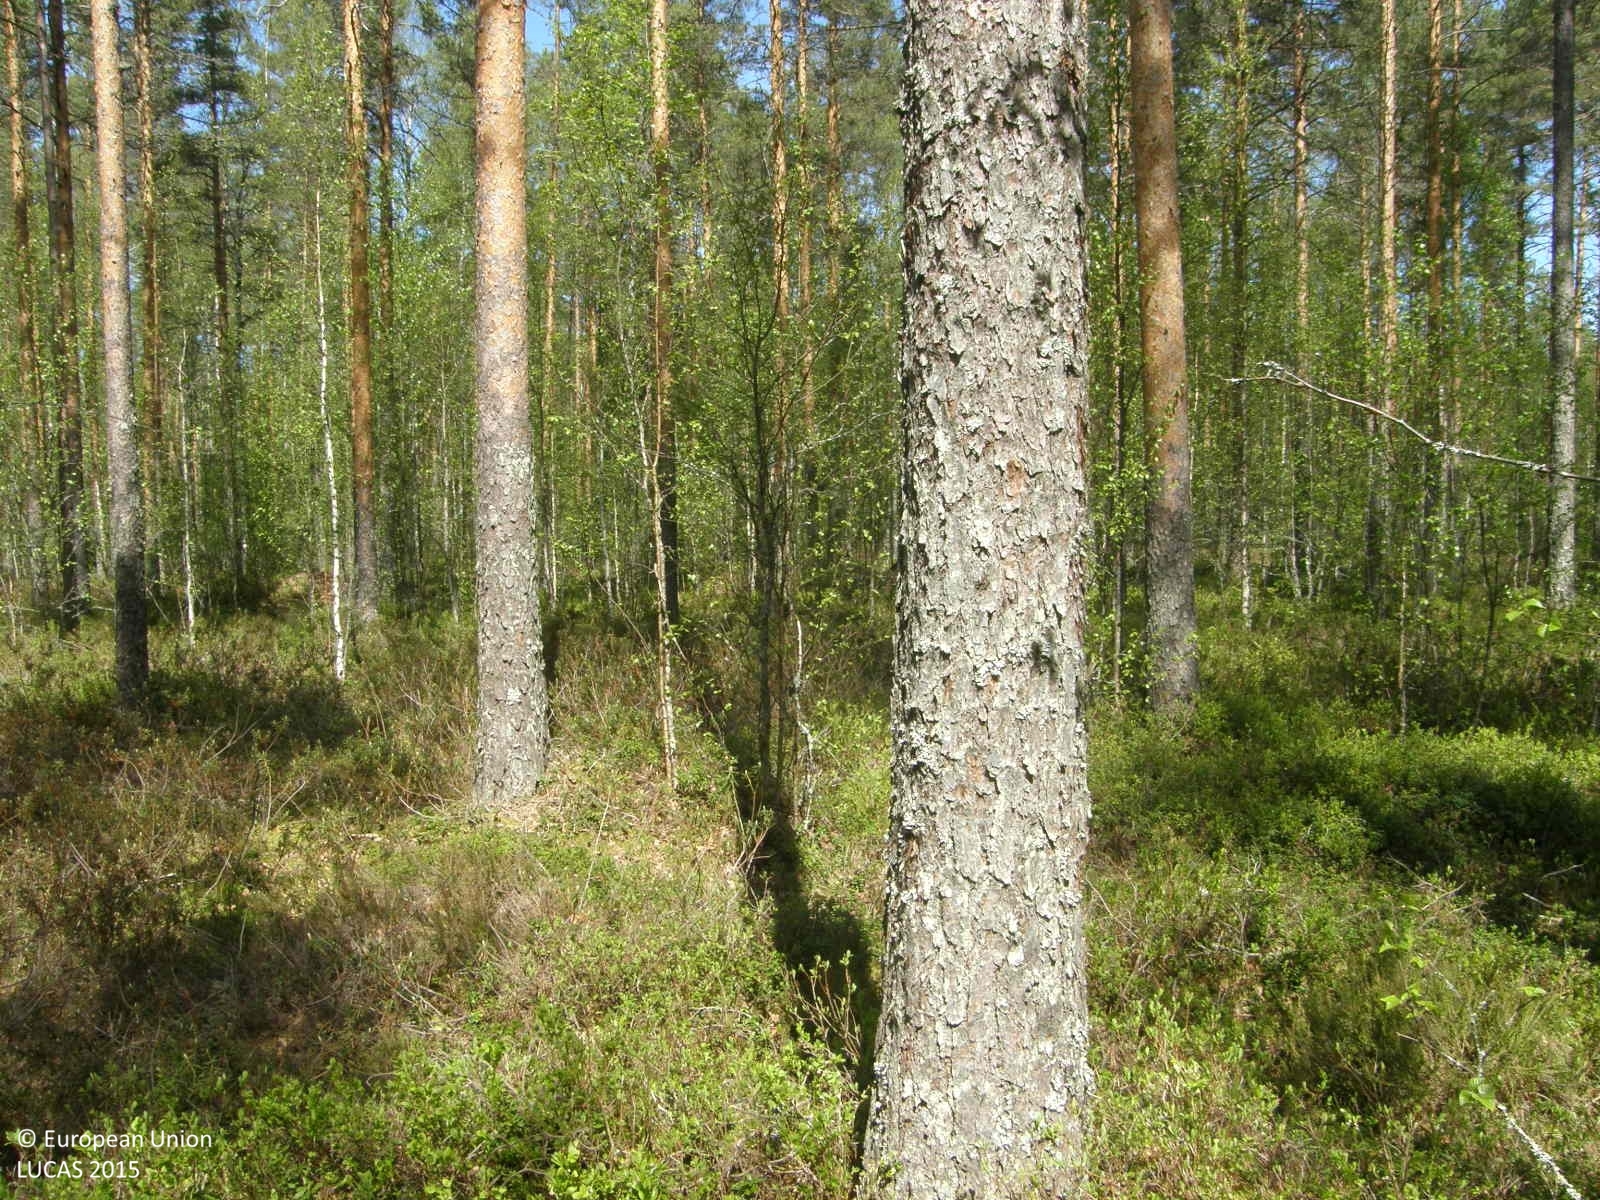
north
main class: Woodland
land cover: Pine dominated coniferous woodland
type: boreal forest
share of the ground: > 75 %
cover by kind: coniferous forest trees 75 %, shrubs 15 %, broadleaved forest trees 10 %
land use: Forestry
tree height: > 5 m
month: June
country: FI
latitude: 62.1590
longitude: 22.3209
